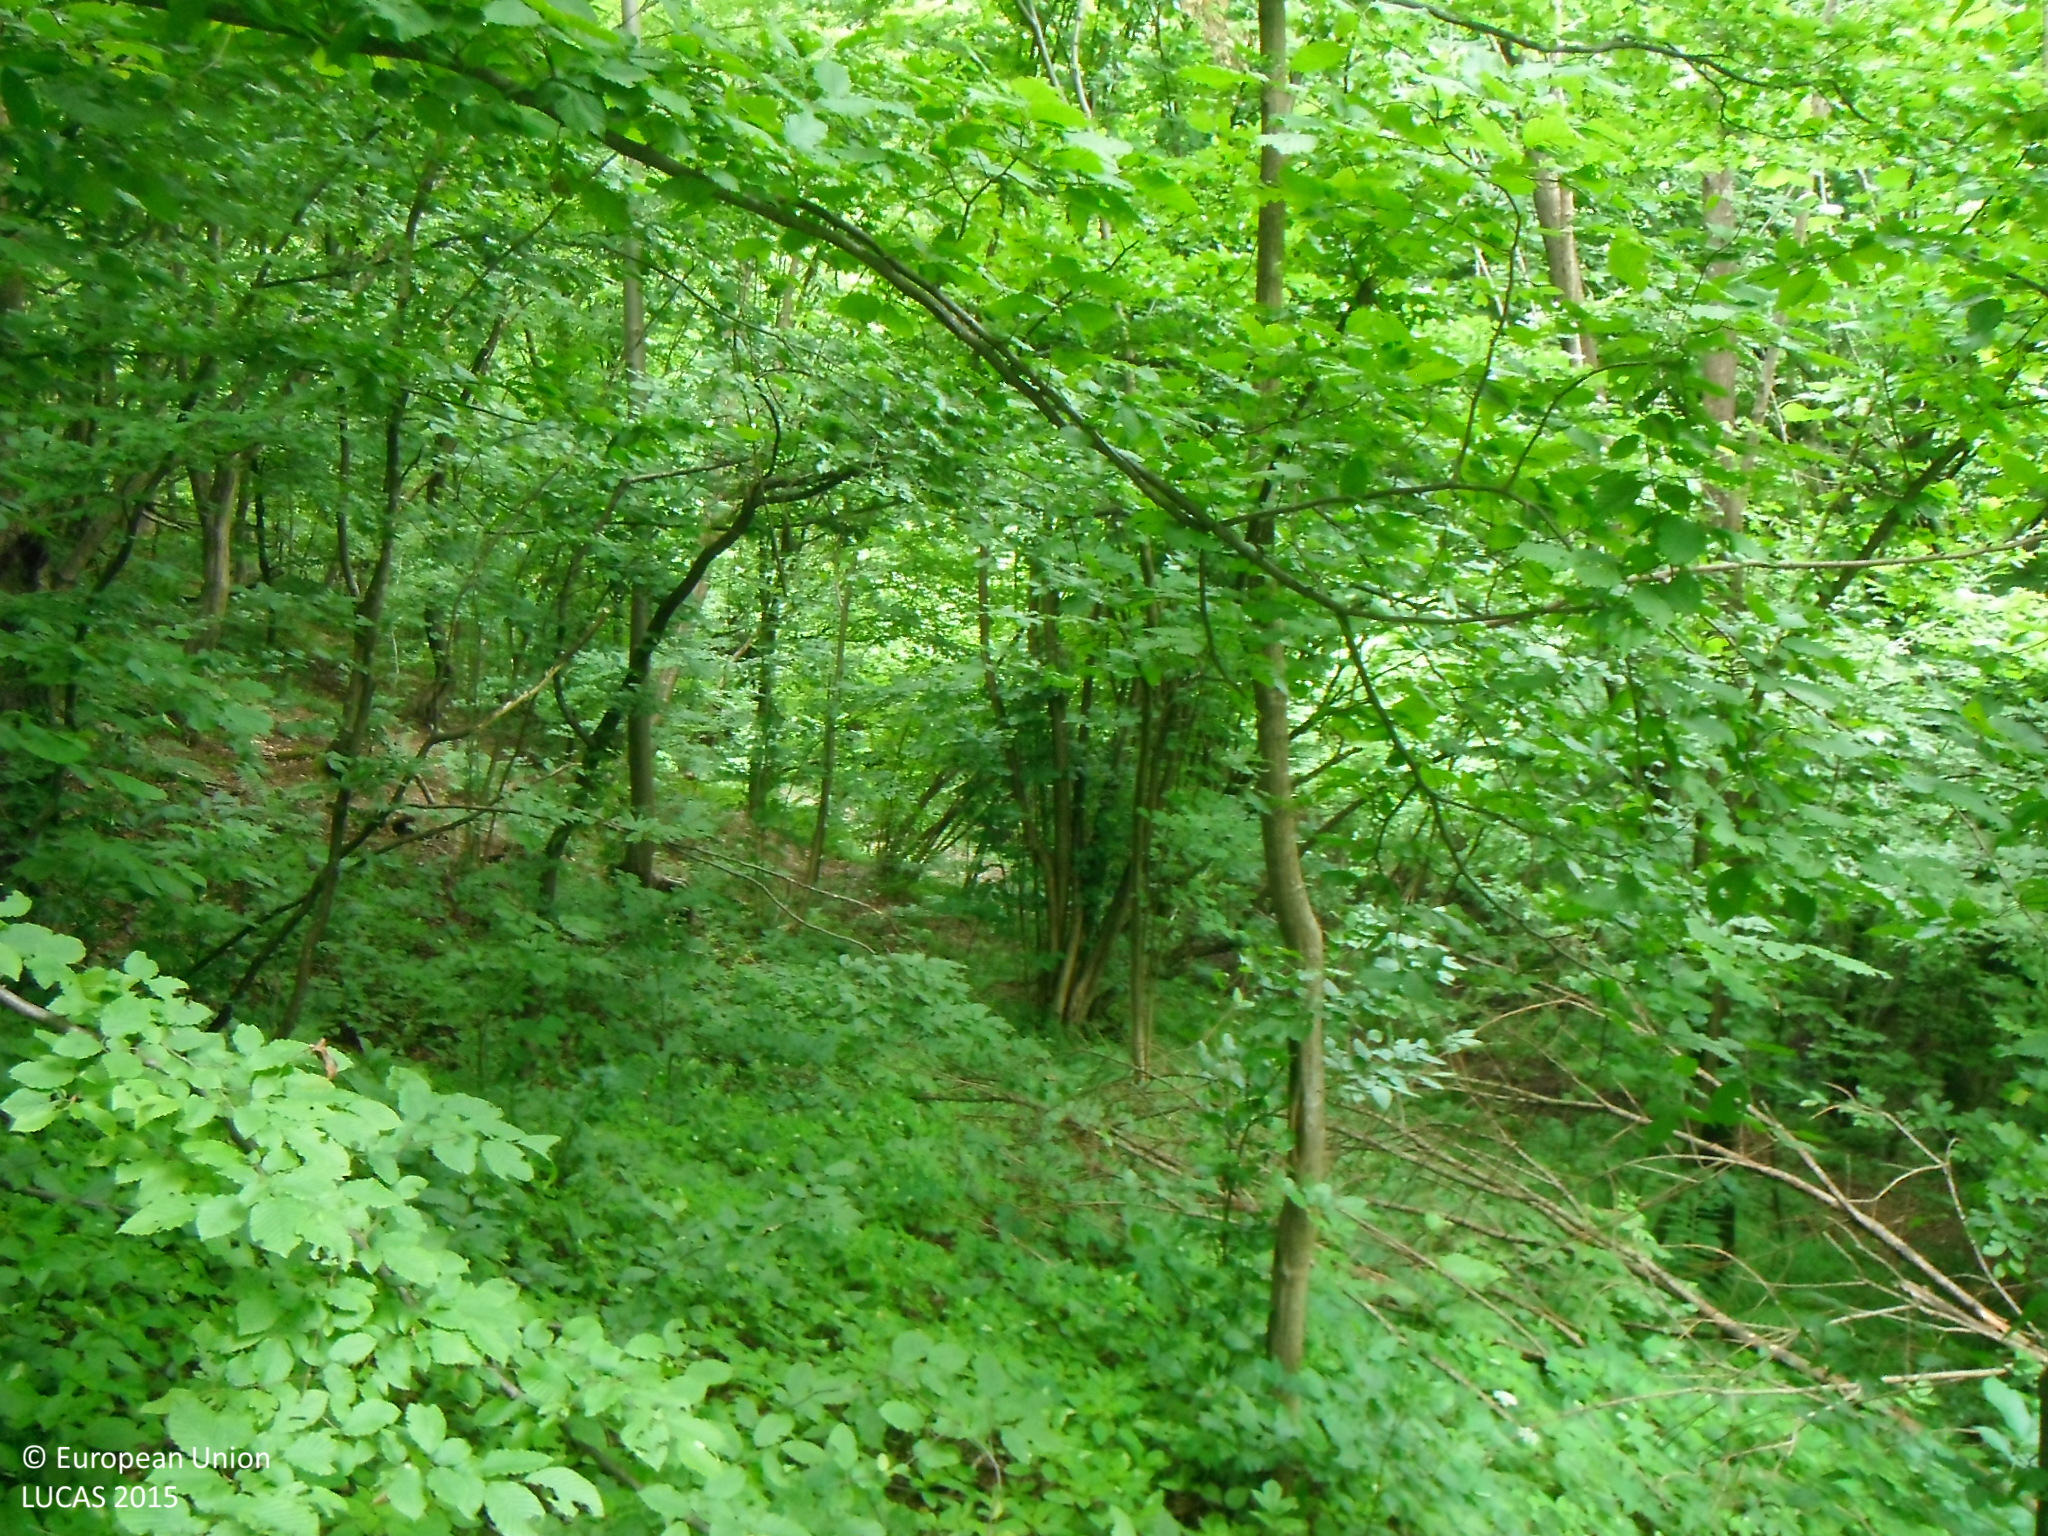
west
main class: Woodland
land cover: Broadleaved woodland
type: mesophytic deciduous forest
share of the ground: > 75 %
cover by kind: broadleaved forest trees 90 %, herbaceous plants 10 %
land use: Forestry
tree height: > 5 m
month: June
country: SK
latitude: 48.6246
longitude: 19.9468
